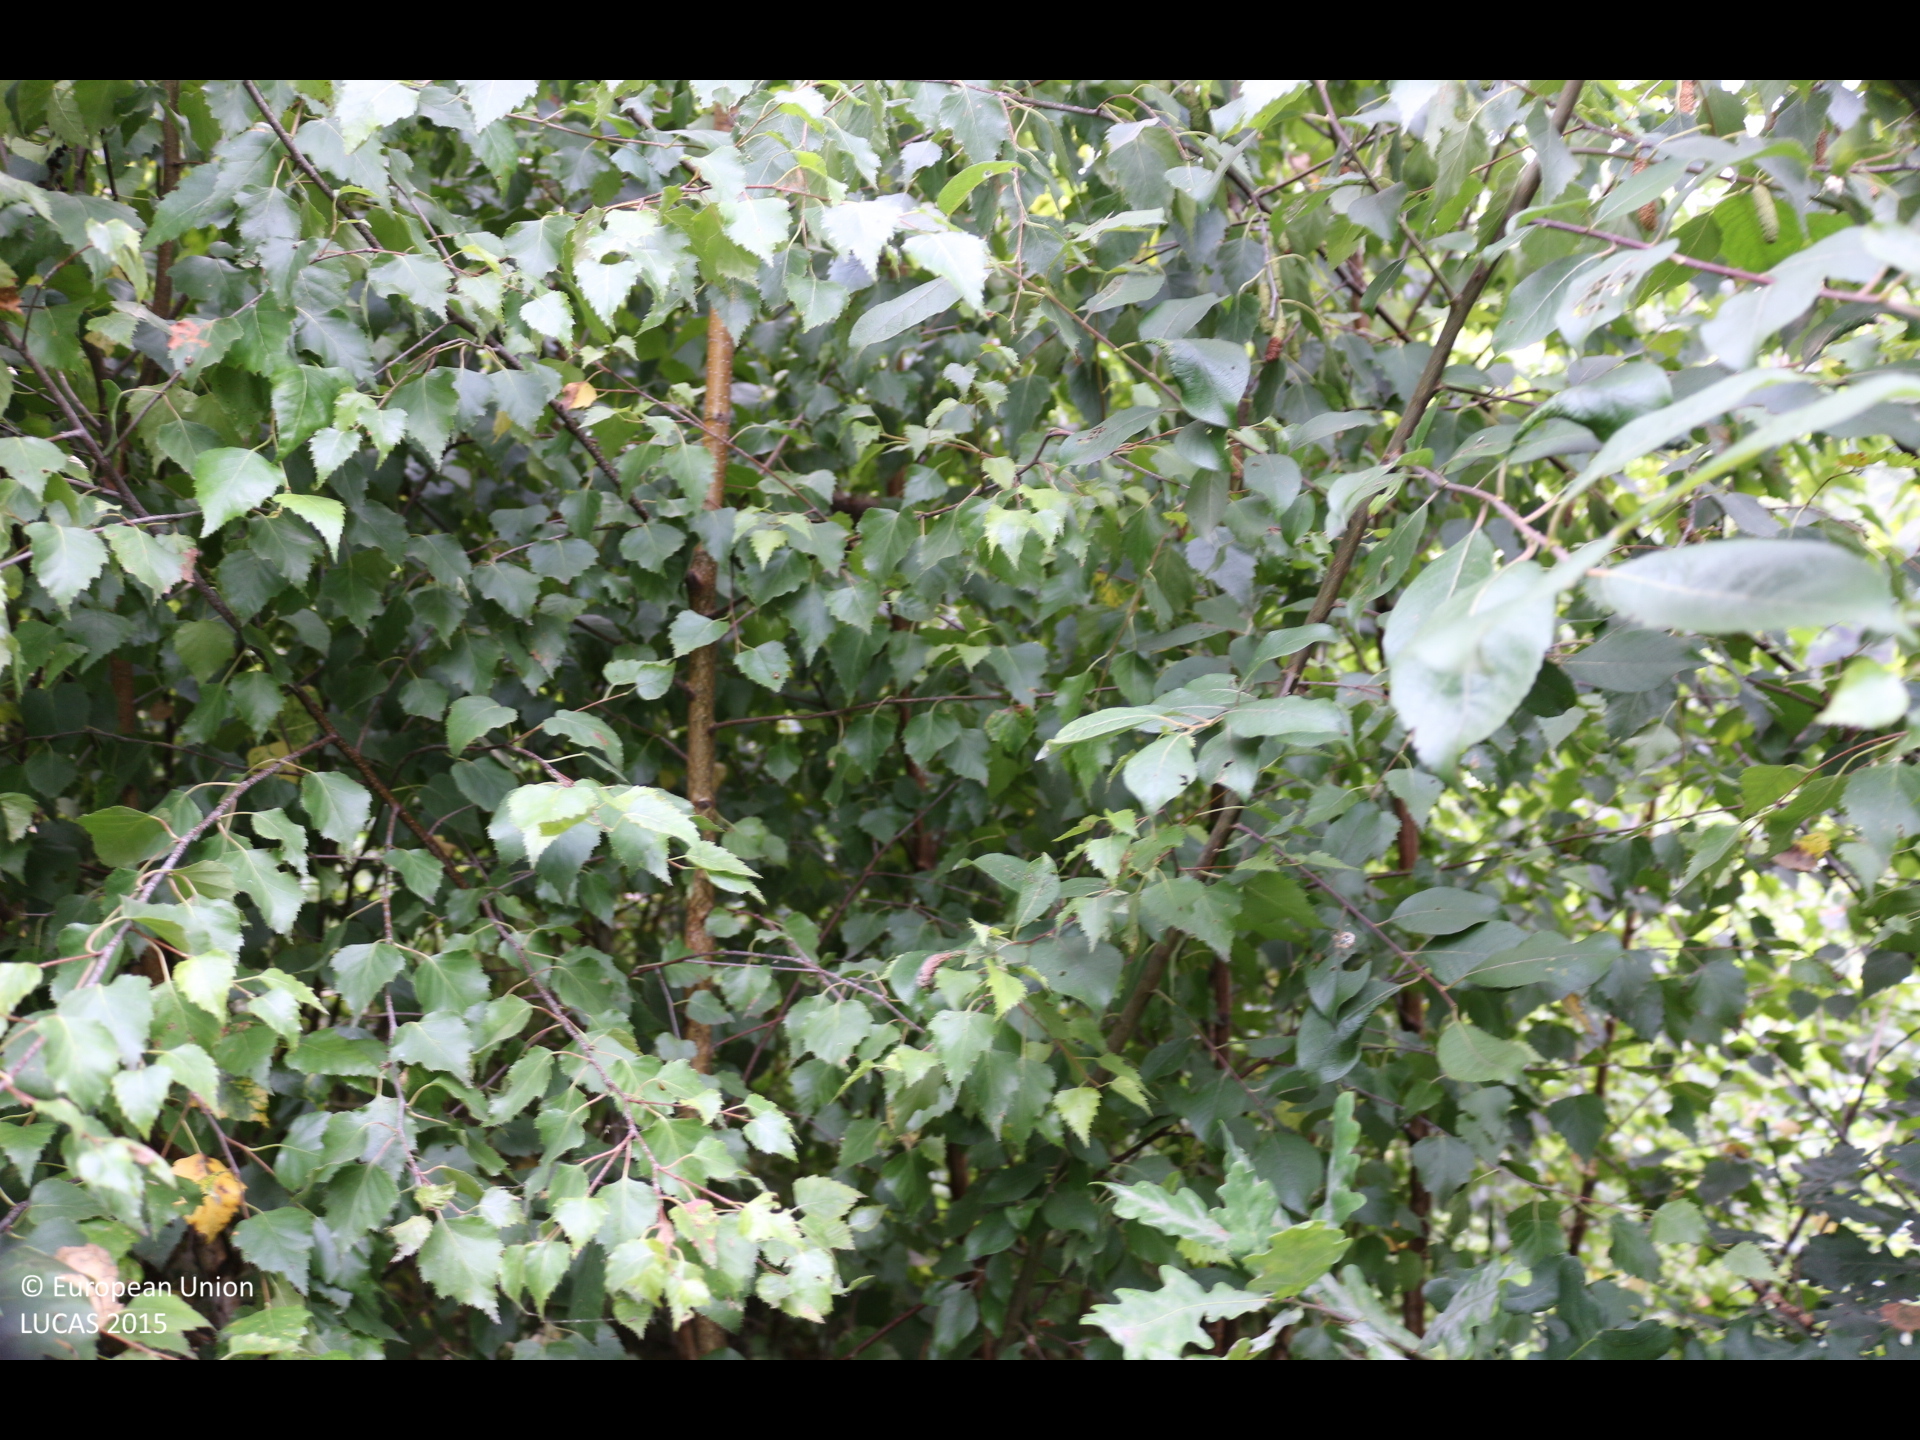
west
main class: Shrubland
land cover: Shrubland with sparse tree cover
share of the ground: > 75 %
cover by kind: shrubs 80 %, herbaceous plants 15 %, broadleaved forest trees 5 %
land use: Forestry
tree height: < 5 m
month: July
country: AT
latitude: 46.8168
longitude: 13.4969
